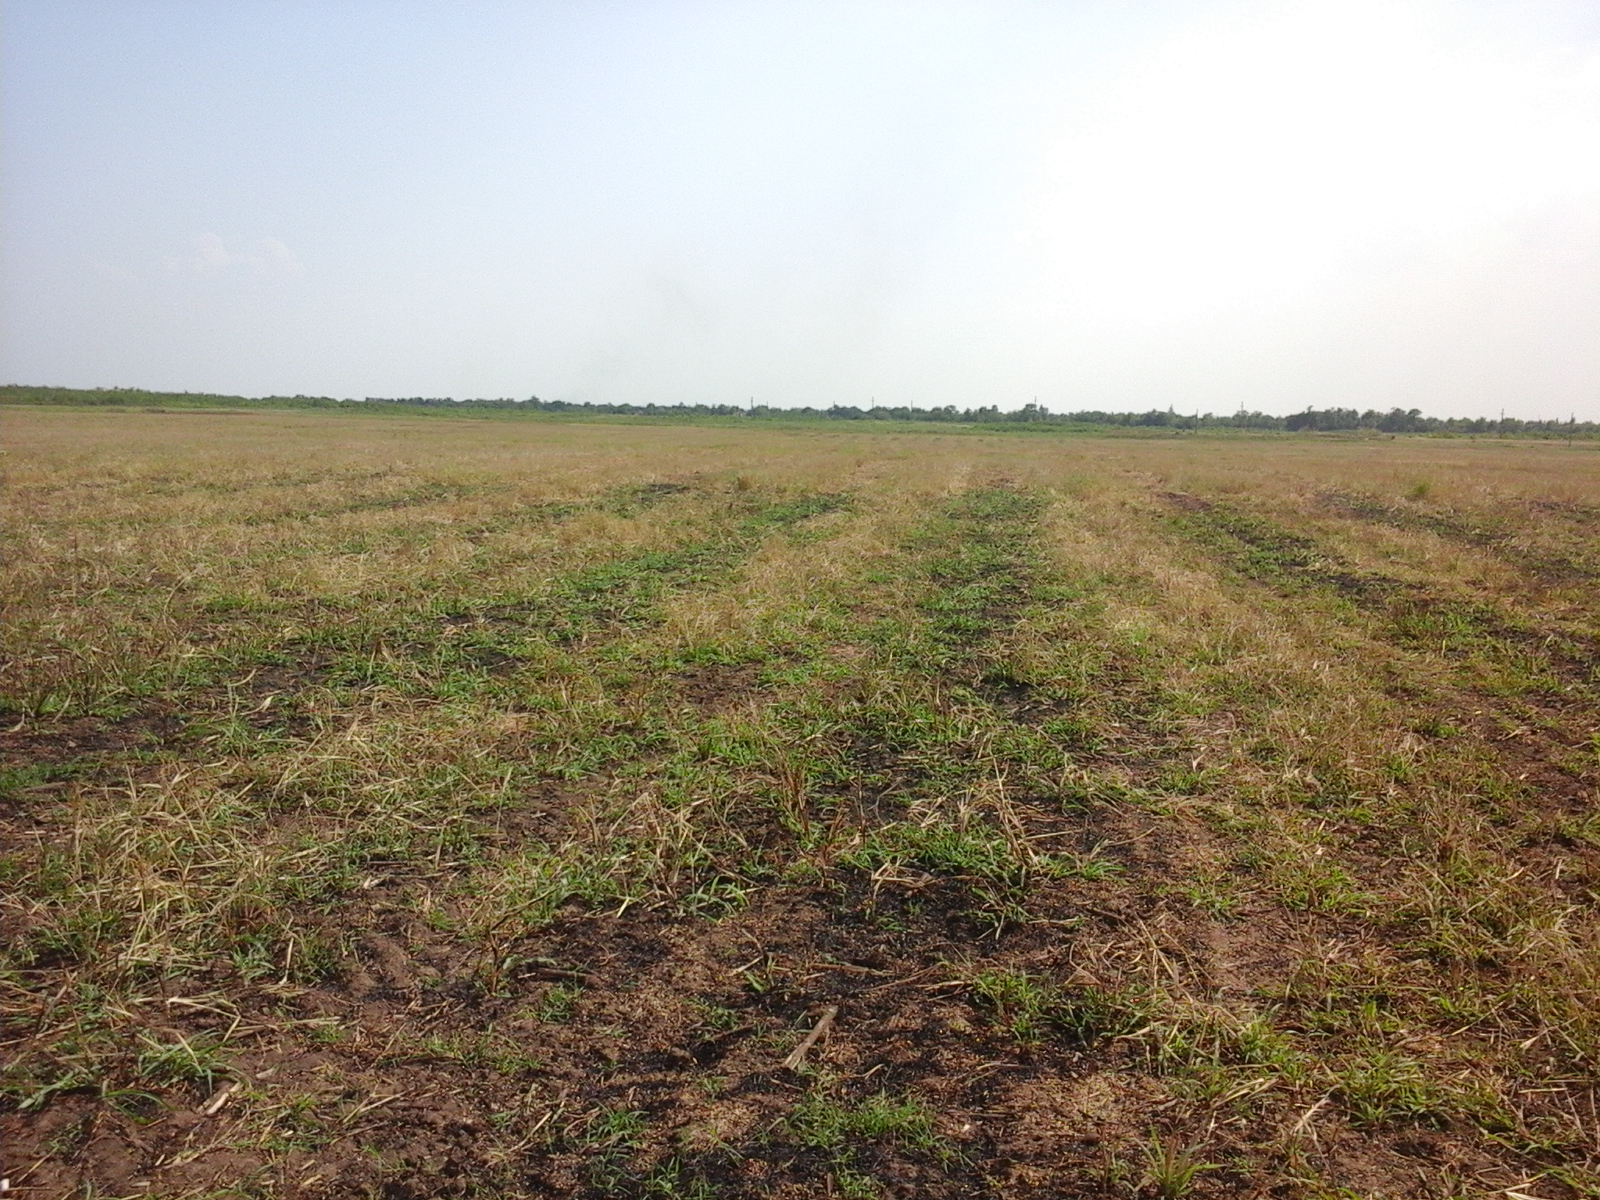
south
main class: Cropland
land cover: Common wheat
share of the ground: 50 - 75 %
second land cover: Spontaneously vegetated surfaces
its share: > 75 %
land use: Agriculture (excluding fallow land and kitchen gardens)
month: August
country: RO
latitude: 43.9850
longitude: 23.4257
